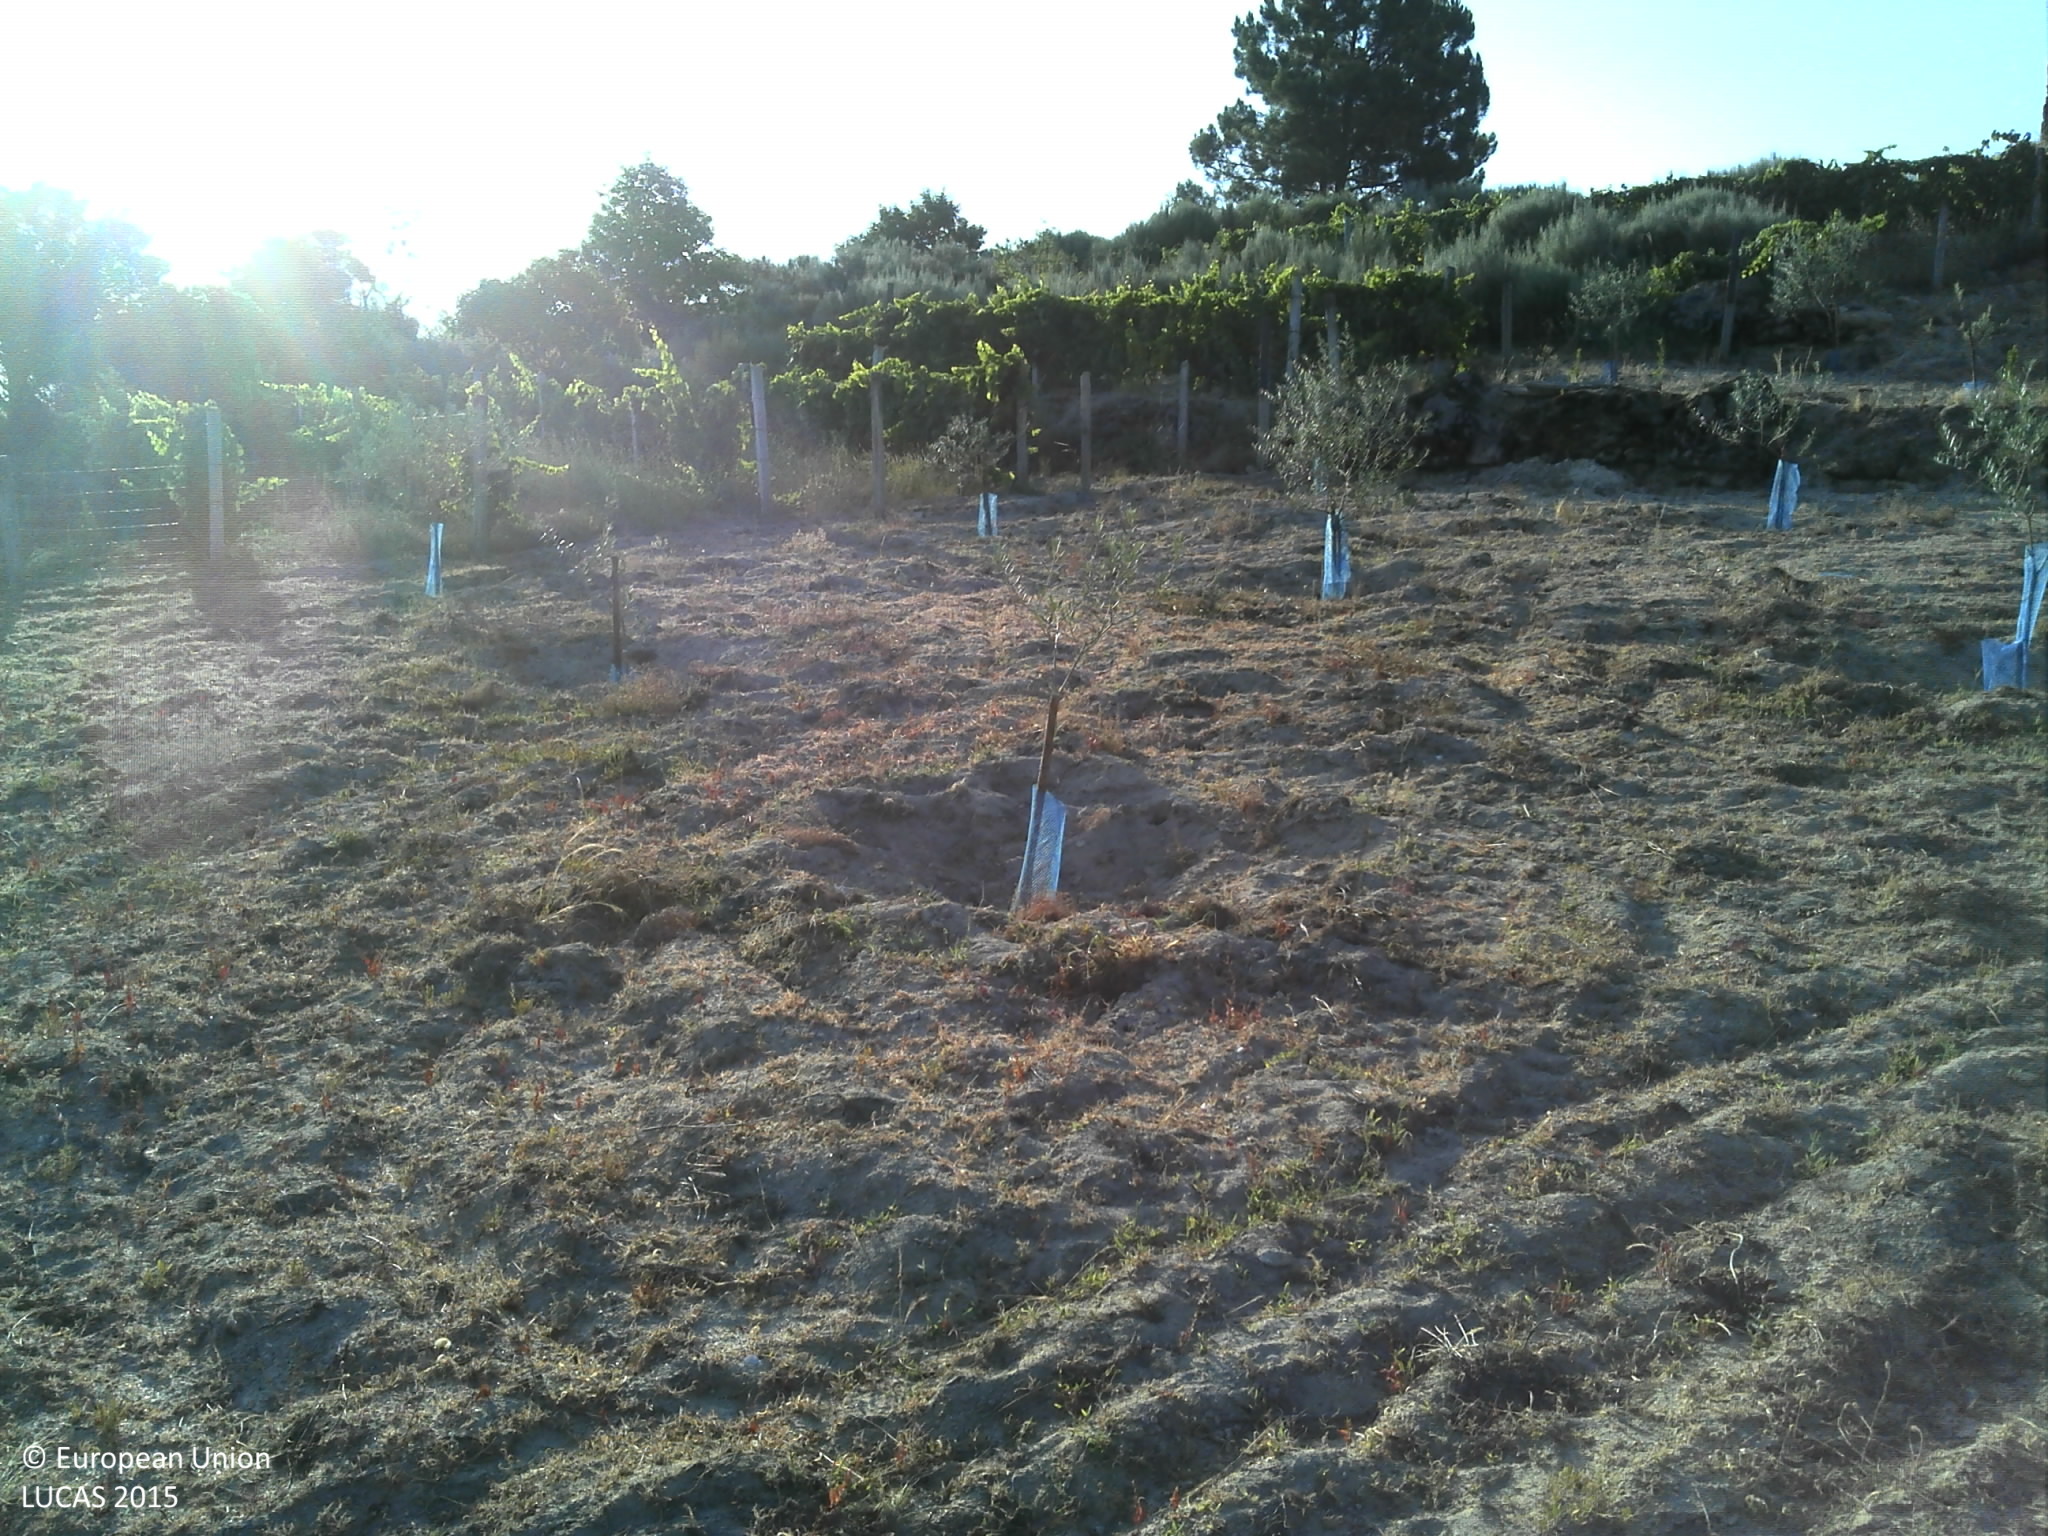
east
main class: Cropland
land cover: Olive groves
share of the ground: < 10 %
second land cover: Other bare soil
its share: > 75 %
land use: Agriculture (excluding fallow land and kitchen gardens)
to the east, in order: Olive groves; Other bare soil; Fences; Vineyards; Nuts trees; Shrubland with sparse tree cover; Rock outcrops; Shrubland with sparse tree cover; Rivers and streams; Shrubland with sparse tree cover; Rock outcrops; Shrubland with sparse tree cover
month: July
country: PT
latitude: 41.3832
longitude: -7.4513
